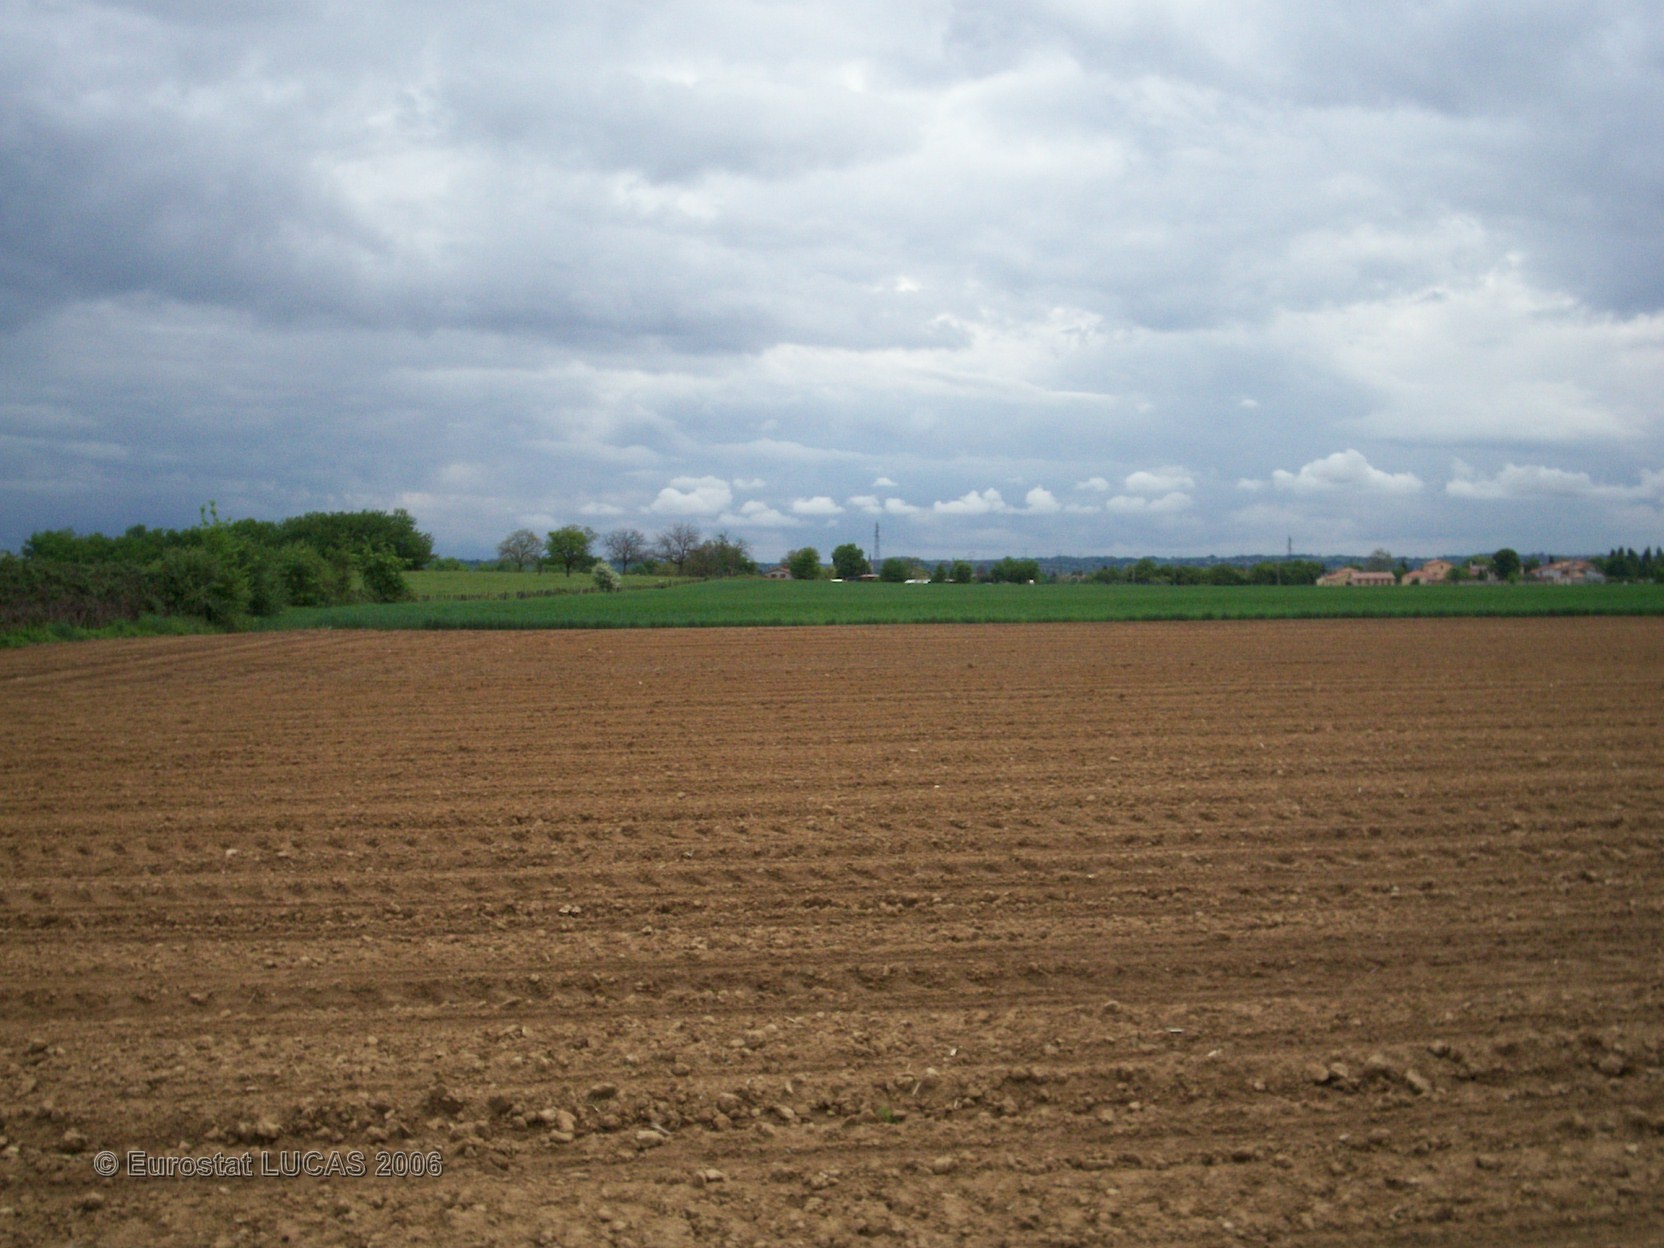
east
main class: Cropland
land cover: Maize
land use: Agriculture (excluding fallow land and kitchen gardens)
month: May
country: FR
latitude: 45.9157
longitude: 4.7557
